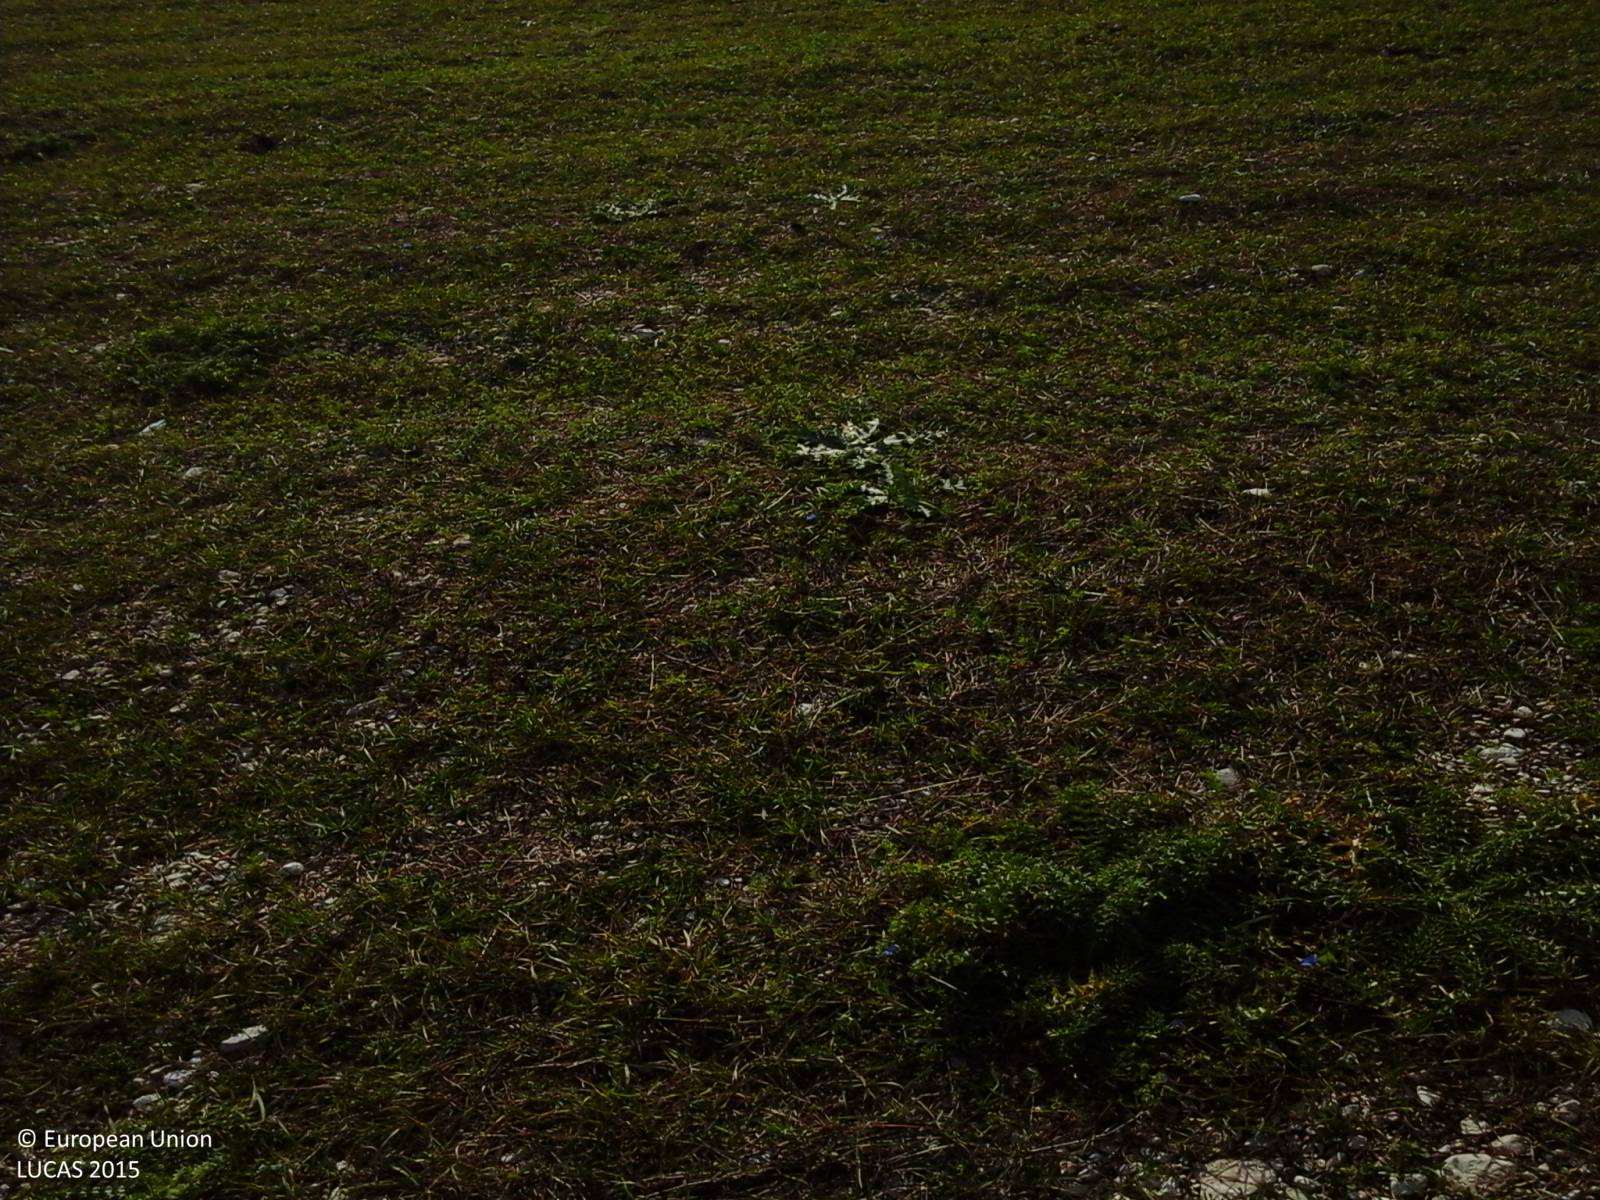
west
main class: Grassland
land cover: Grassland without tree/shrub cover
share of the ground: > 75 %
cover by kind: herbaceous plants 100 %
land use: Agriculture (excluding fallow land and kitchen gardens)
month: October
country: IT
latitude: 42.8201
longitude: 13.2074
